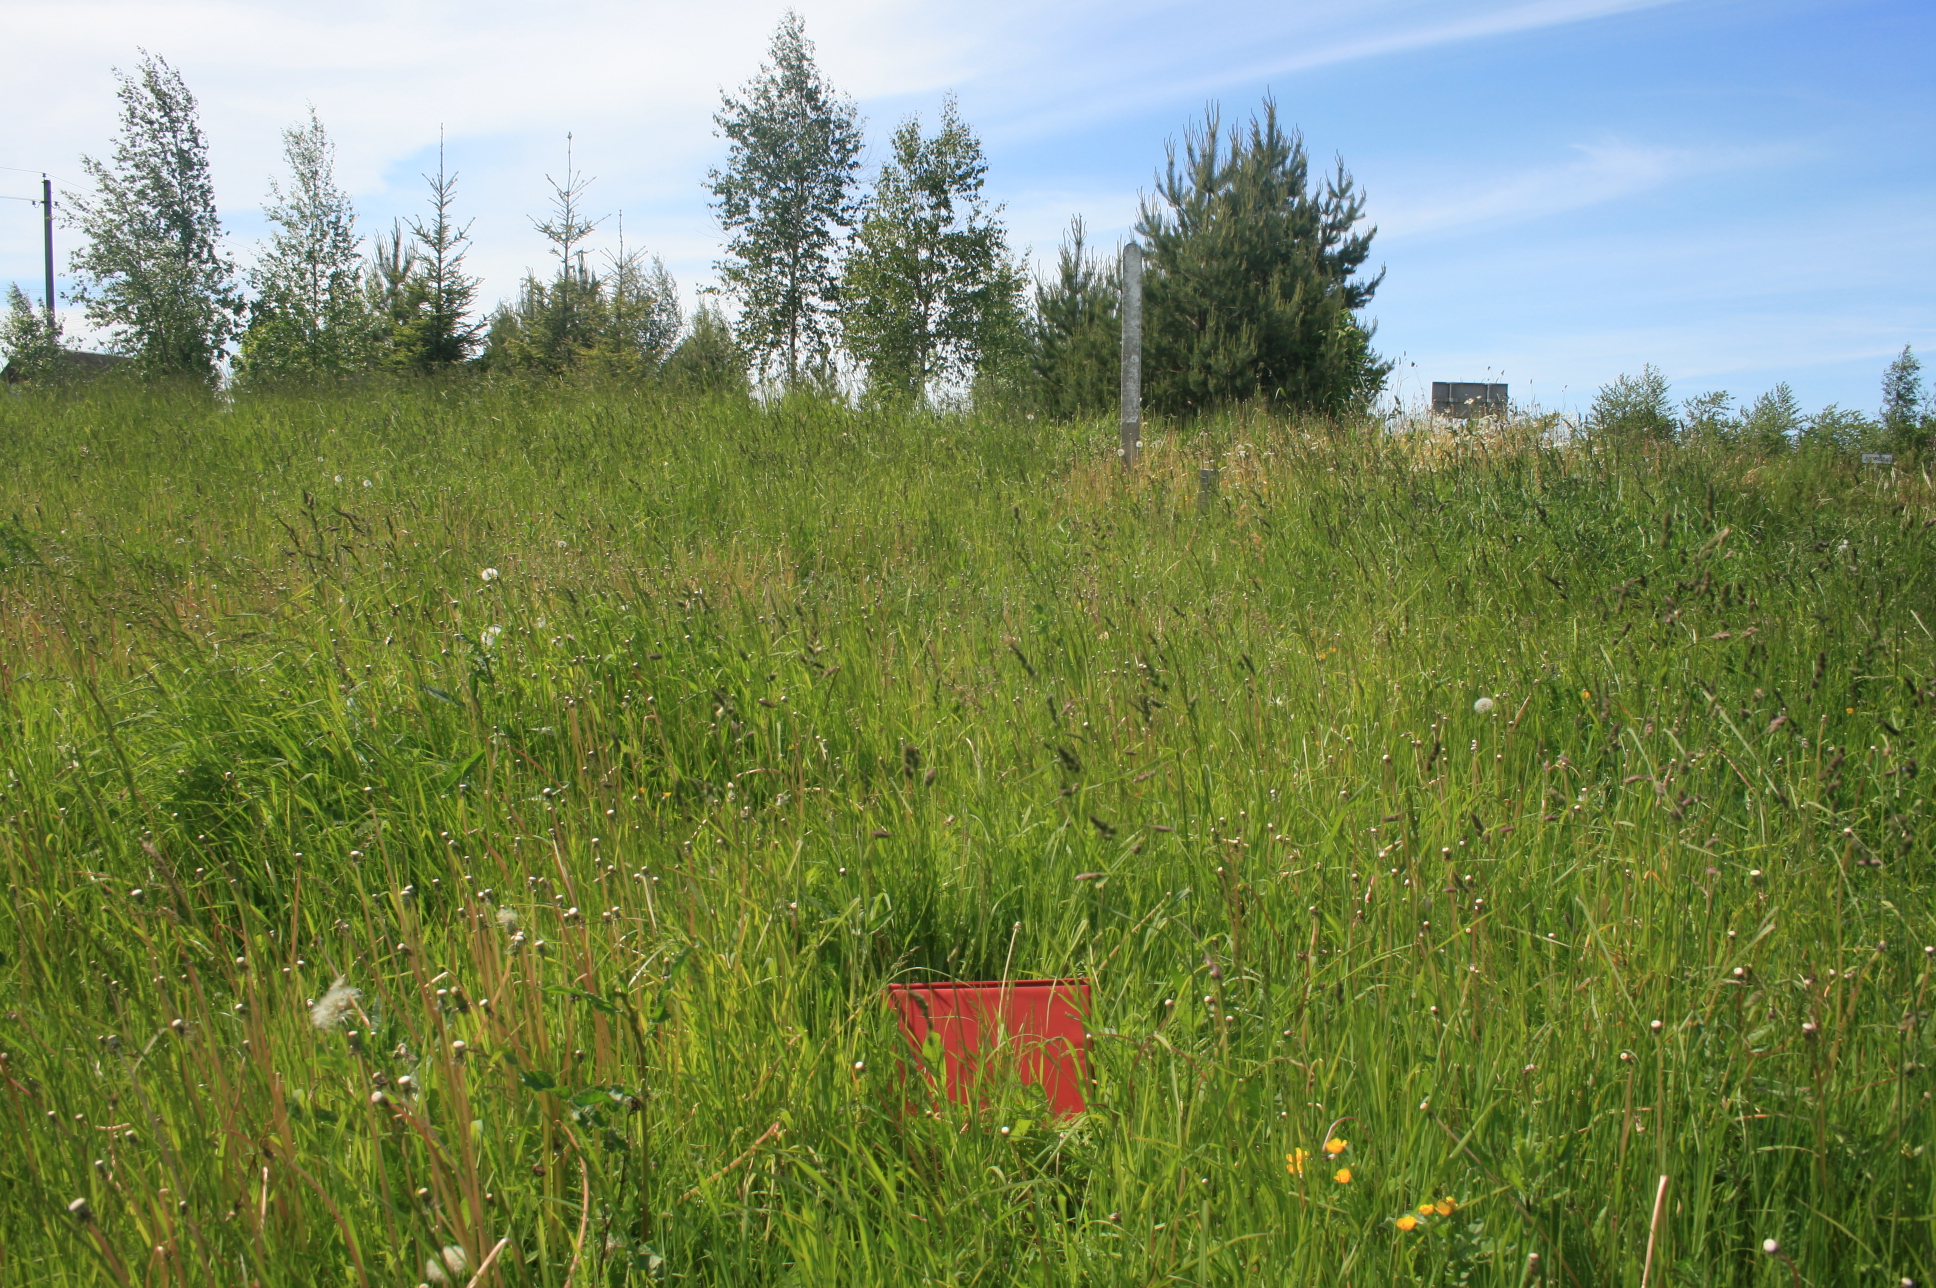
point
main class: Grassland
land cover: Grassland without tree/shrub cover
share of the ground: > 75 %
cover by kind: herbaceous plants 100 %
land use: Agriculture (excluding fallow land and kitchen gardens)
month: June
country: LT
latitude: 55.9358
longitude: 22.3351
